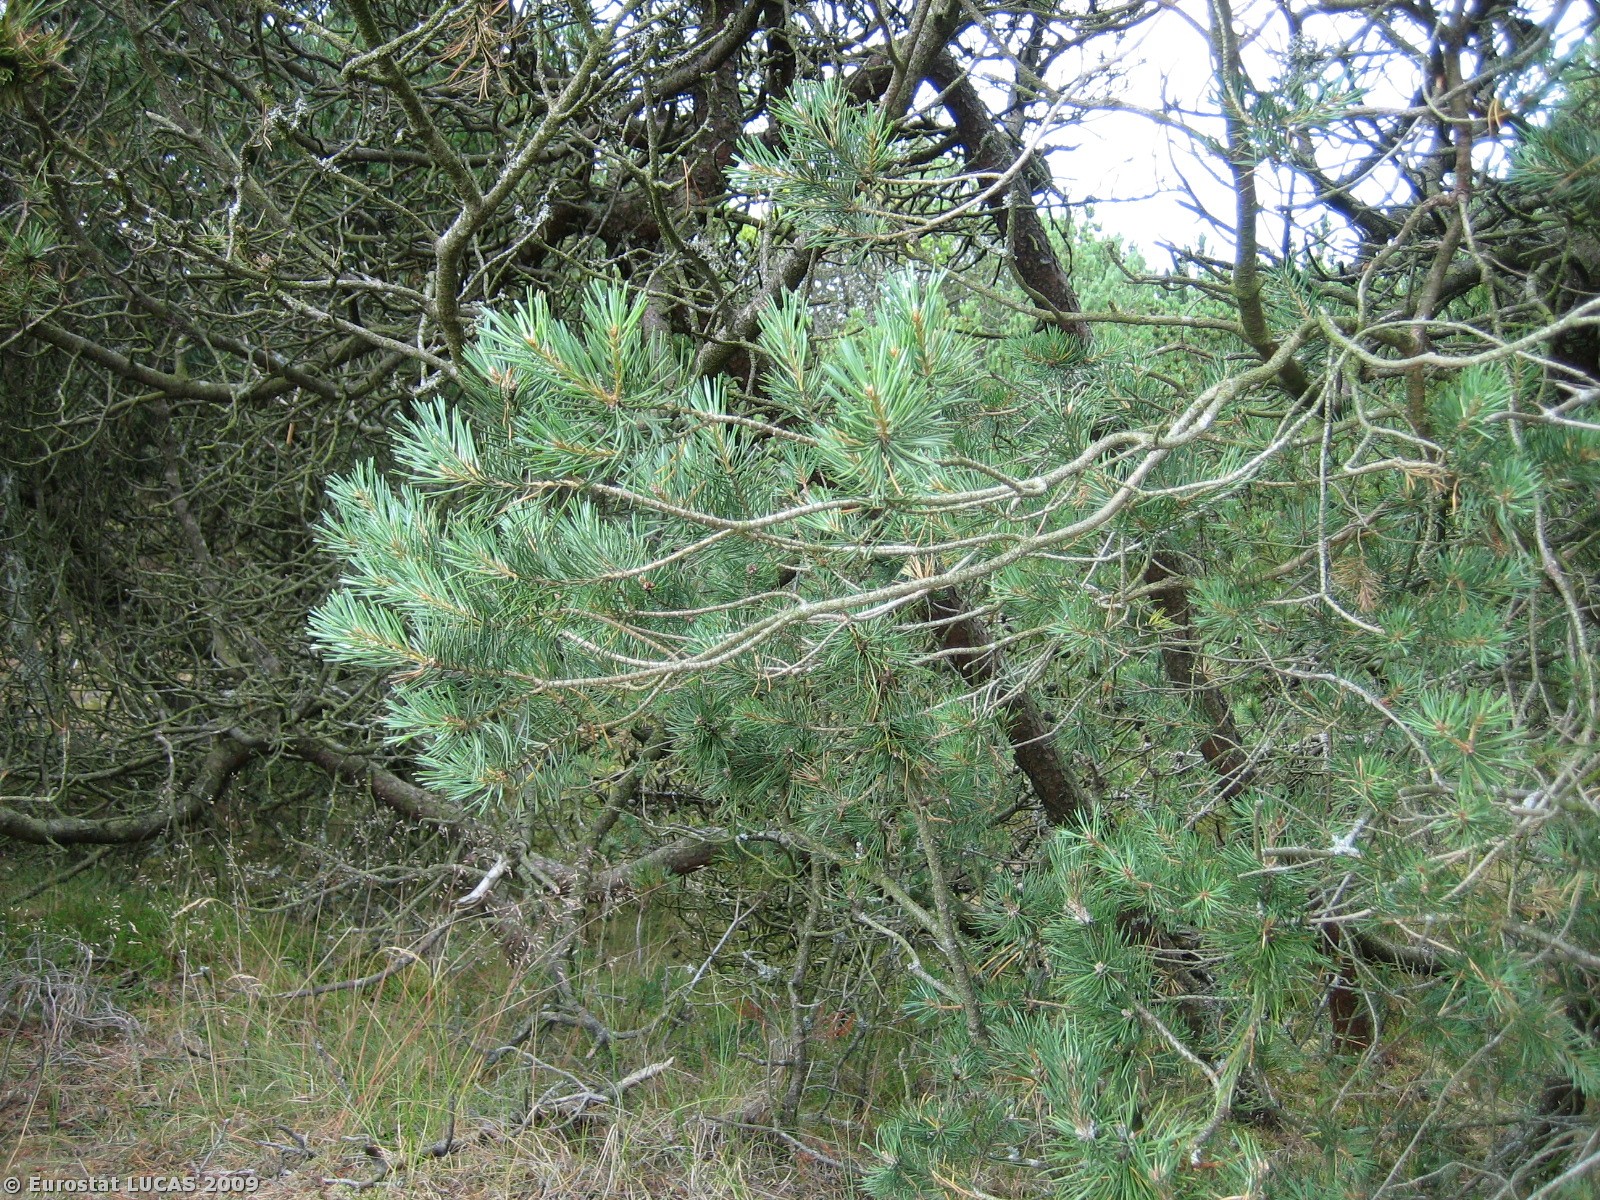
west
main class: Woodland
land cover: Coniferous woodland
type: hemiboreal forest and nemoral coniferous forest and mixed broadleaved-coniferous forest
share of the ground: 50 - 75 %
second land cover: Bare land
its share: 10 - 25 %
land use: Forestry
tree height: > 5 m
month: July
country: DK
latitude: 55.7621
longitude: 8.2327
